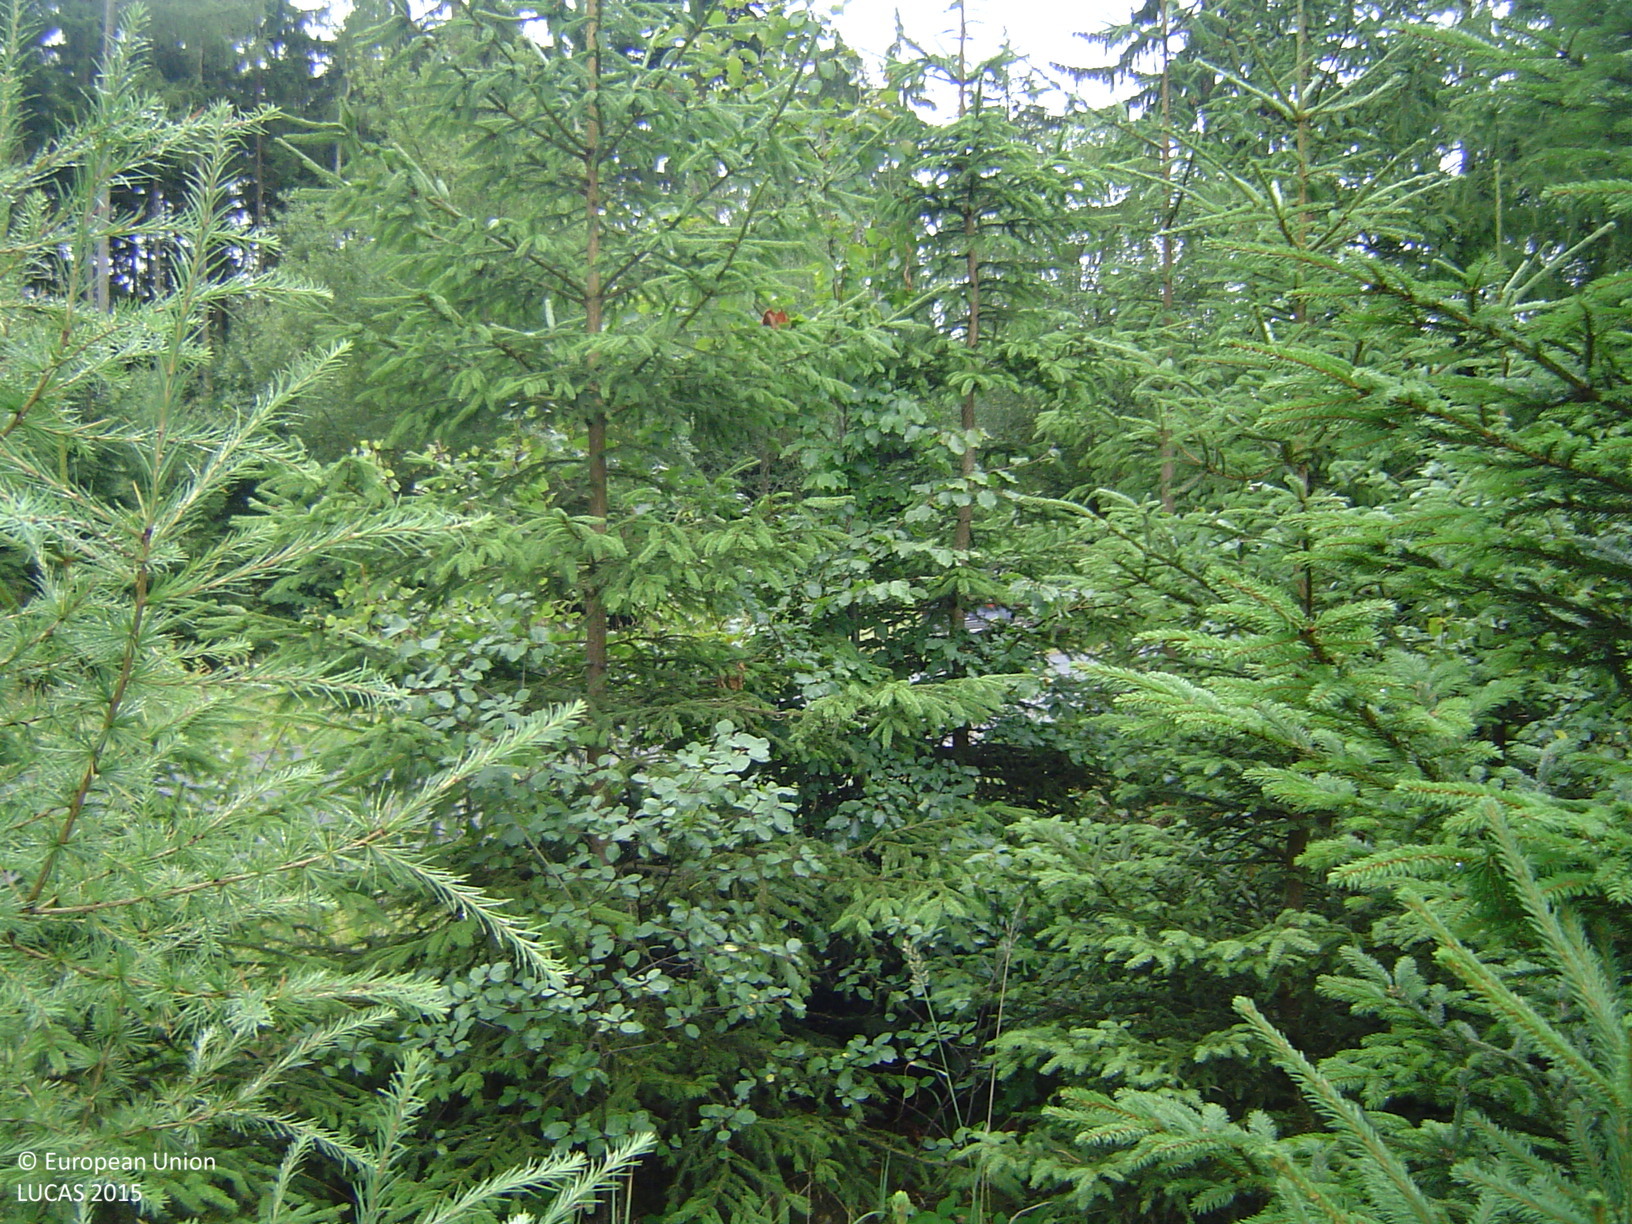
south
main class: Woodland
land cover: Spruce dominated coniferous woodland
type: hemiboreal forest and nemoral coniferous forest and mixed broadleaved-coniferous forest
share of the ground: > 75 %
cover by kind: coniferous forest trees 100 %
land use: Forestry
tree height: > 5 m
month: August
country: CZ
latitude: 49.5628
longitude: 13.8026
